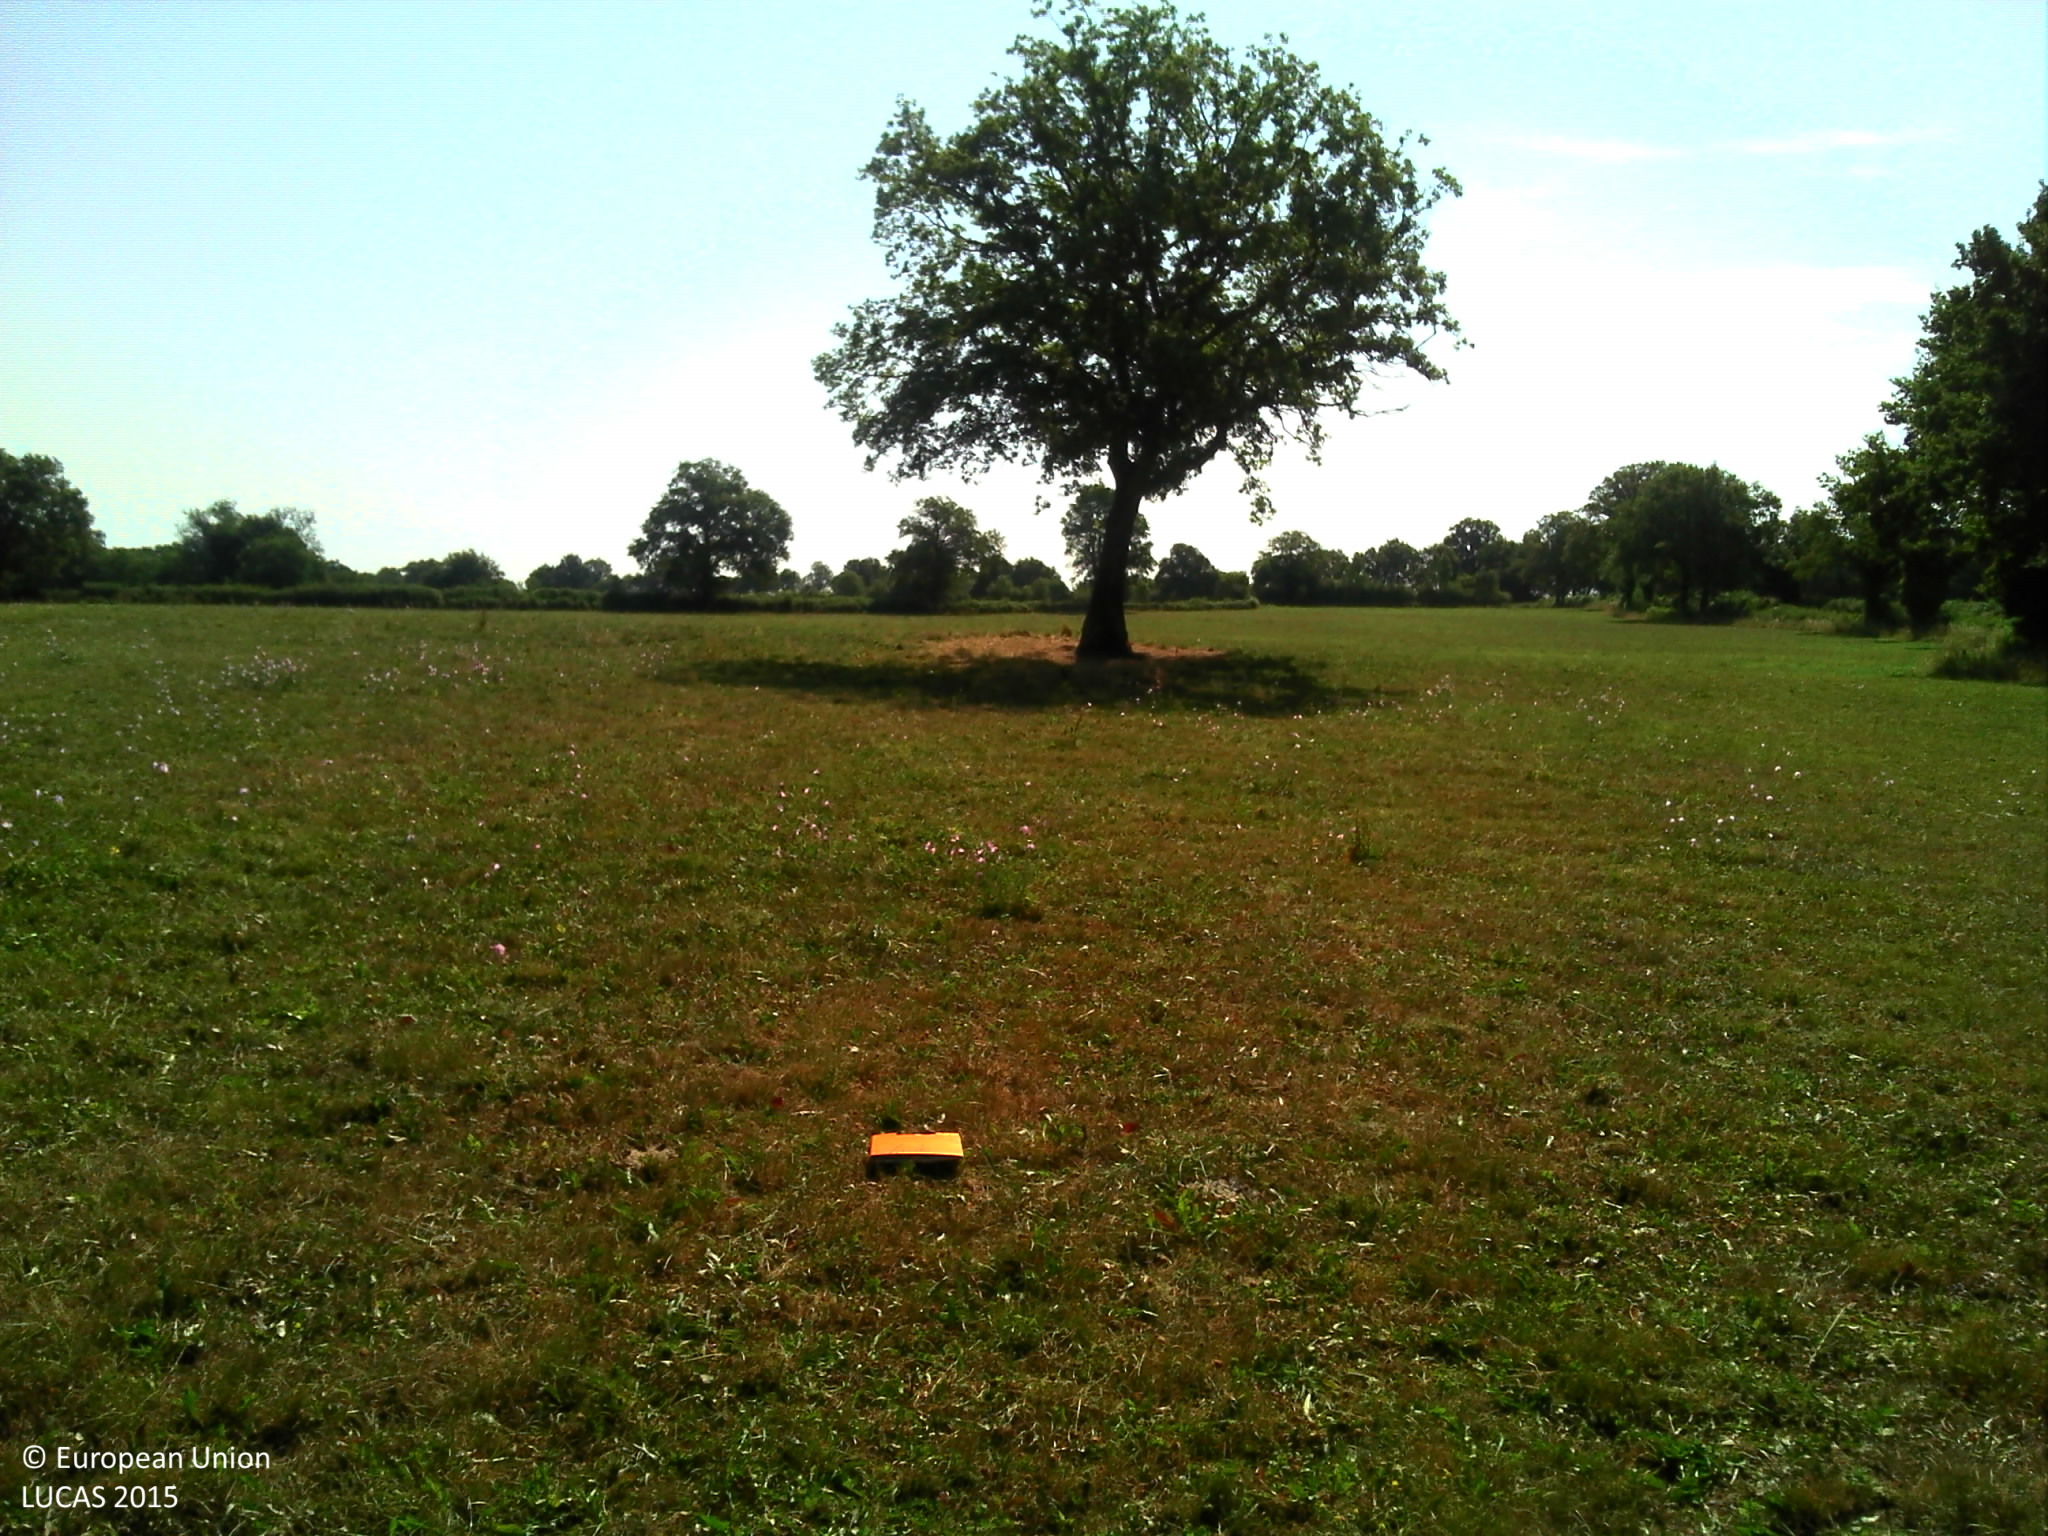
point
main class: Grassland
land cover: Grassland without tree/shrub cover
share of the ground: > 75 %
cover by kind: herbaceous plants 100 %
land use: Agriculture (excluding fallow land and kitchen gardens)
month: July
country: FR
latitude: 46.4655
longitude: 3.0044
